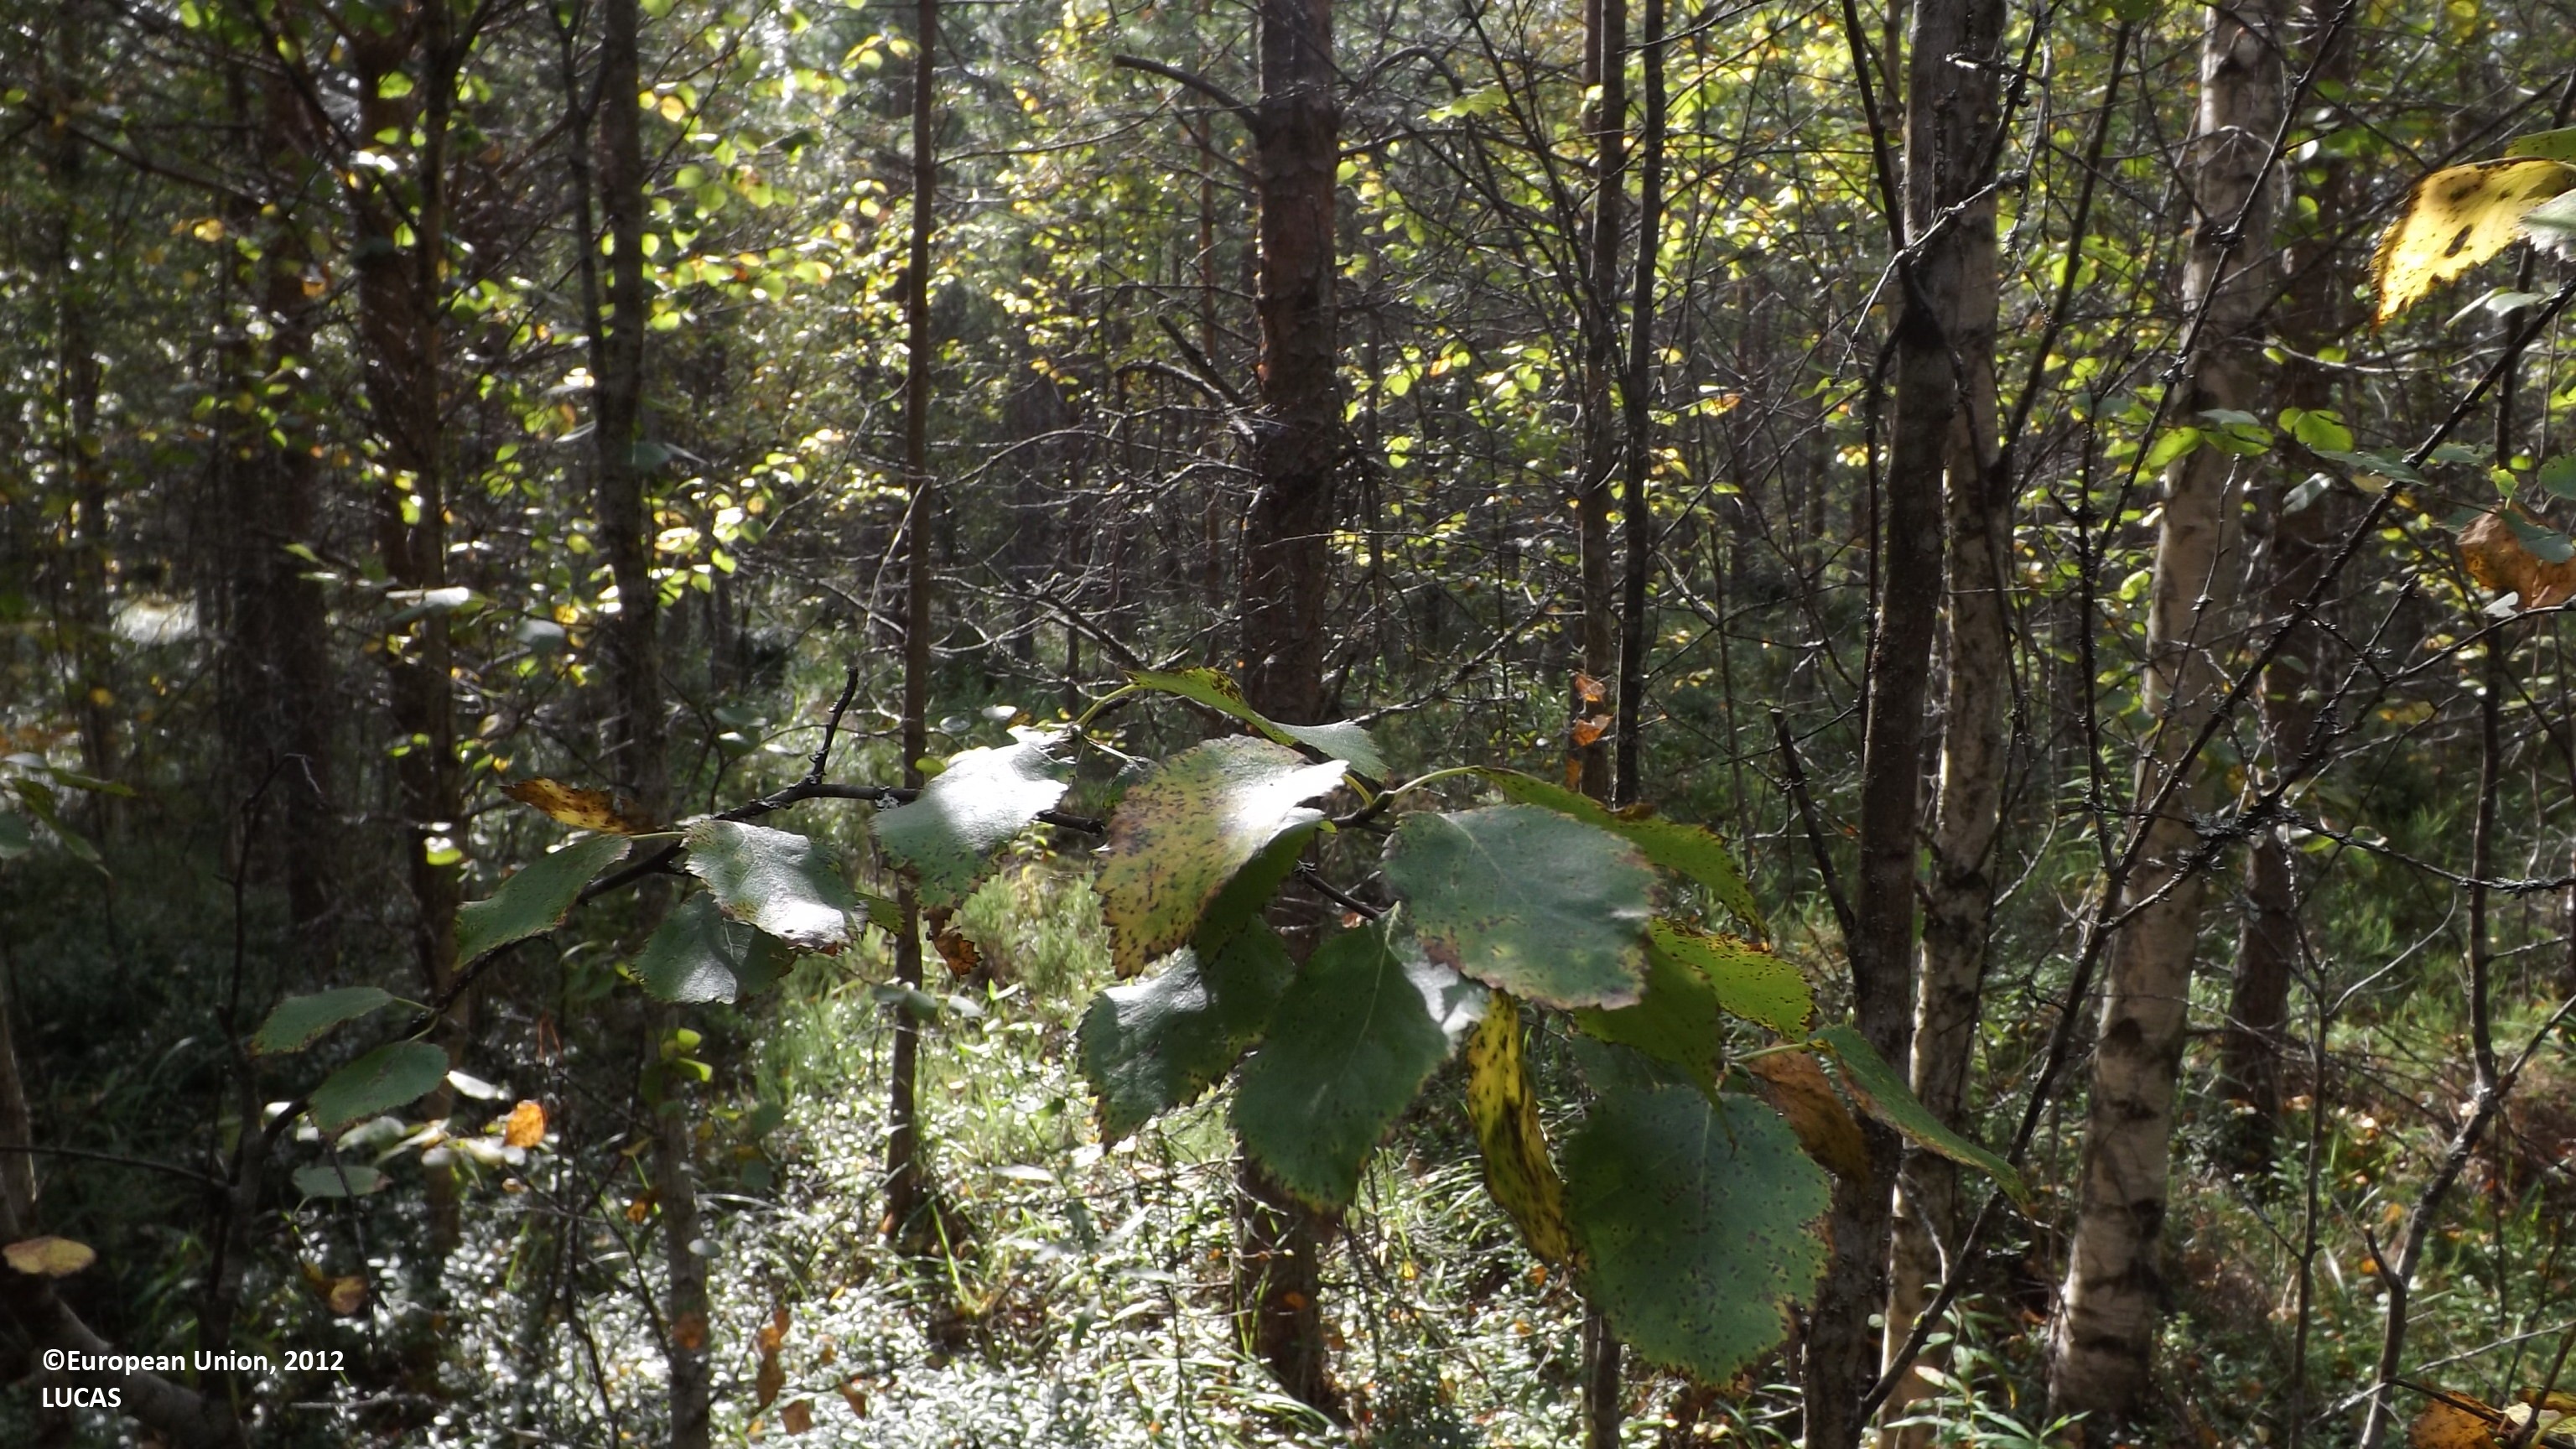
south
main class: Woodland
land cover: Pine dominated mixed woodland
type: boreal forest
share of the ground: > 75 %
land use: Forestry
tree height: > 5 m
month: August
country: FI
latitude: 63.0995
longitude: 24.3247
